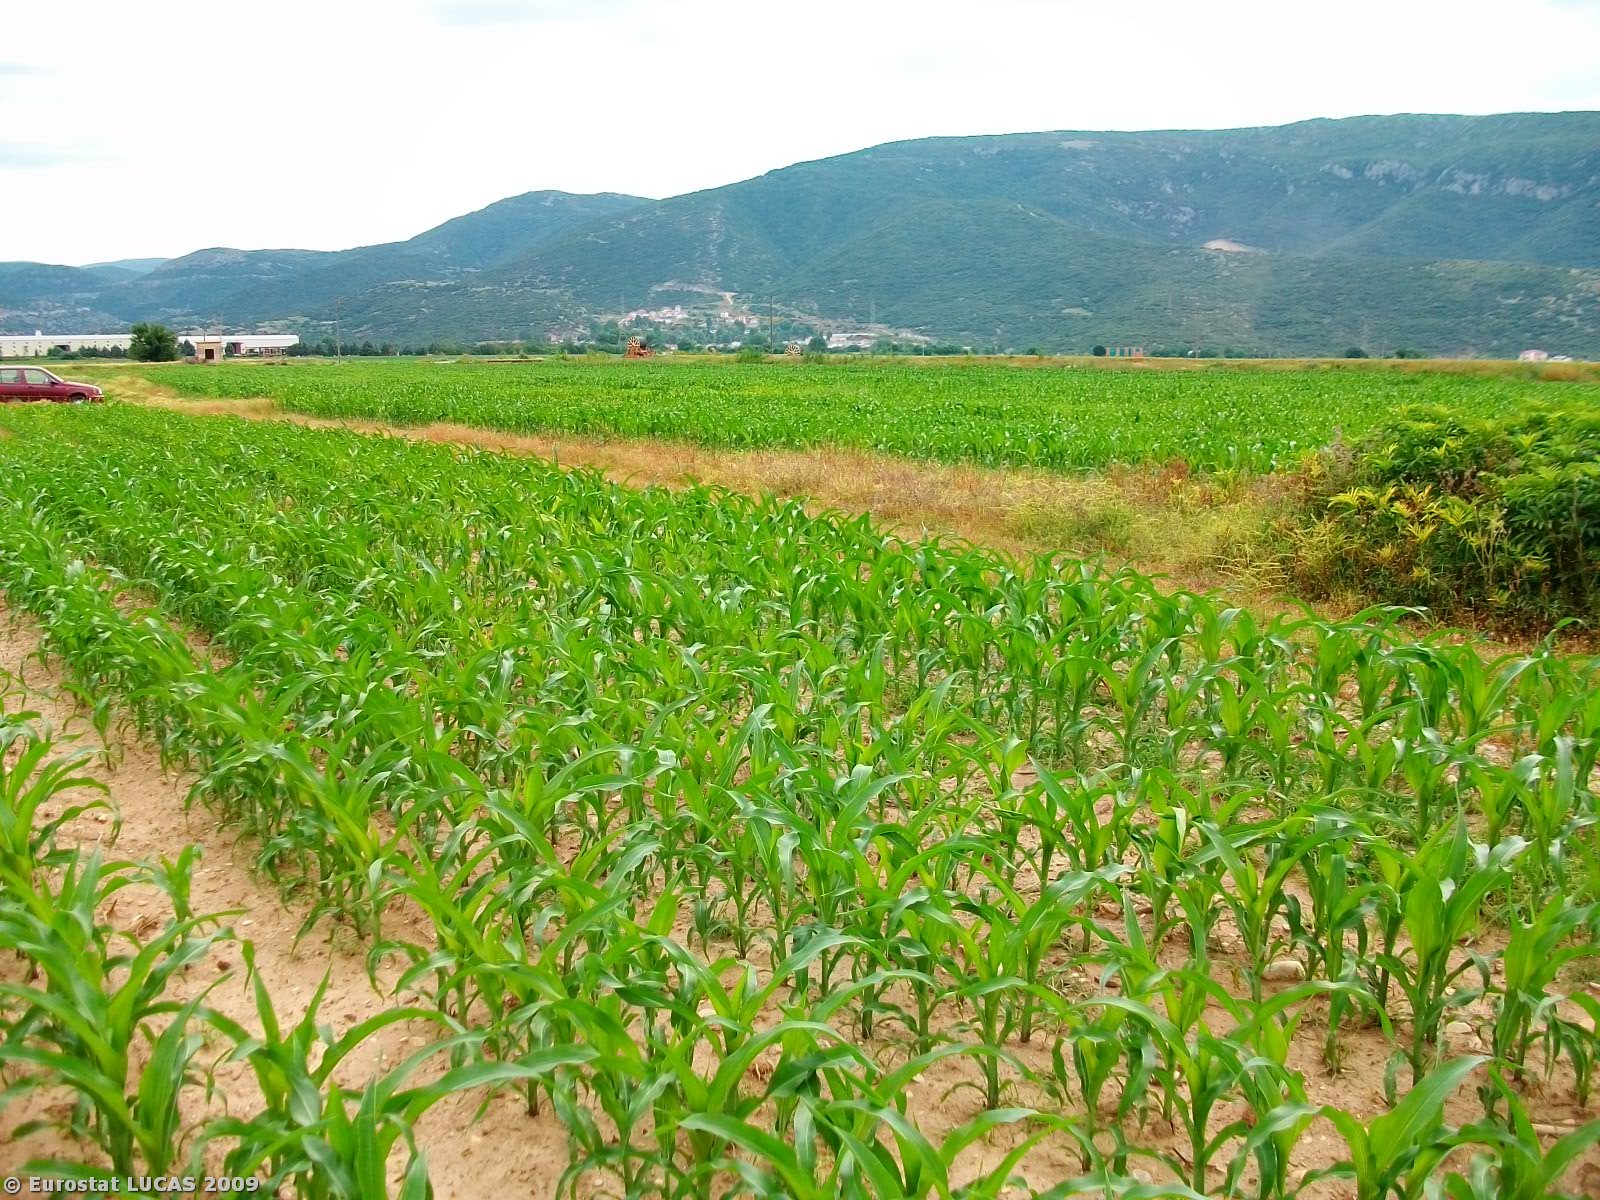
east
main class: Cropland
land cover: Maize
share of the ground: 50 - 75 %
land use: Agriculture (excluding fallow land and kitchen gardens)
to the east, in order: Maize; Tracks; Grass margins; Maize; Grassland without tree/shrub cover; Maize; Tracks; Maize; Grass margins; Paved roads, cycling and walking lanes; Grass margins; Shruby margins; Electric lines; Ditches and canals; Shruby margins; Grass margins; Paved roads, cycling and walking lanes; Grass margins; Common wheat; Grass margins; Paved roads, cycling and walking lanes
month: May
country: GR
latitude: 40.9845
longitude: 24.3529
